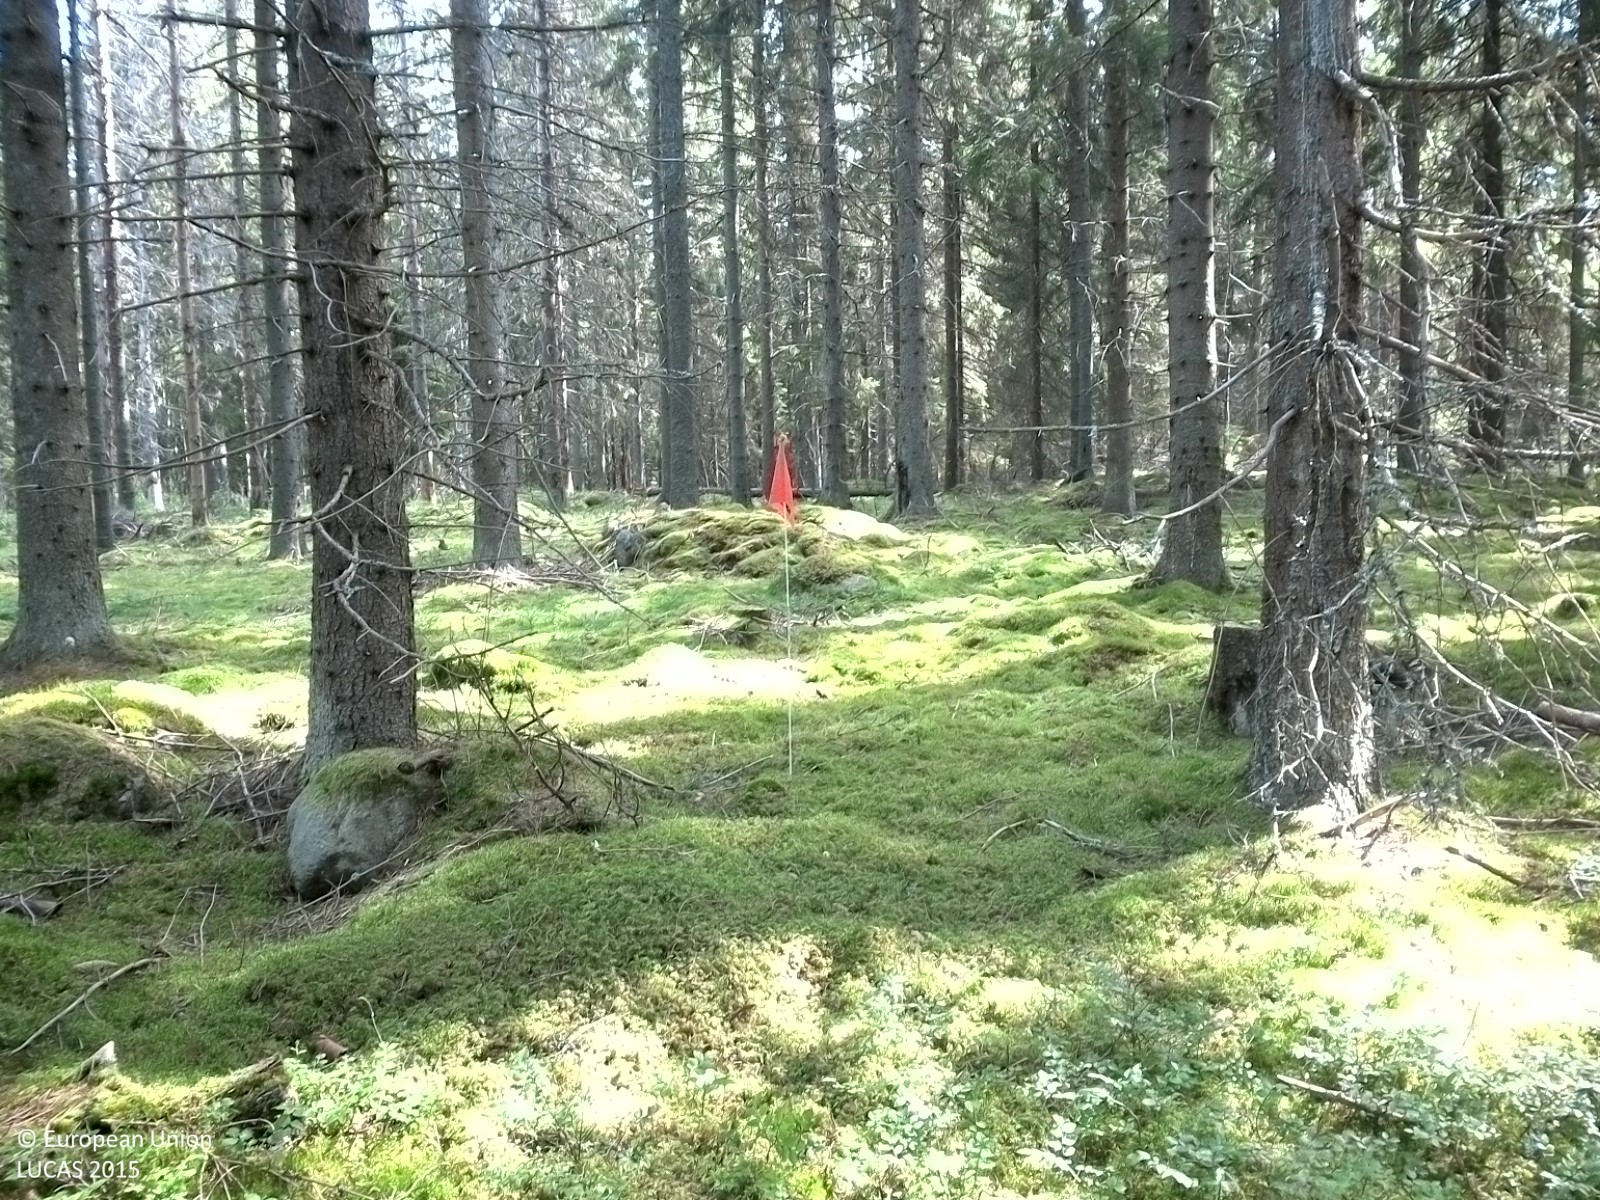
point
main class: Woodland
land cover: Spruce dominated coniferous woodland
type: boreal forest
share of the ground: 50 - 75 %
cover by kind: coniferous forest trees 60 %, lichens and mosses 30 %, herbaceous plants 10 %
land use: Forestry
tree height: > 5 m
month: August
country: SE
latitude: 59.0536
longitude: 14.7866
